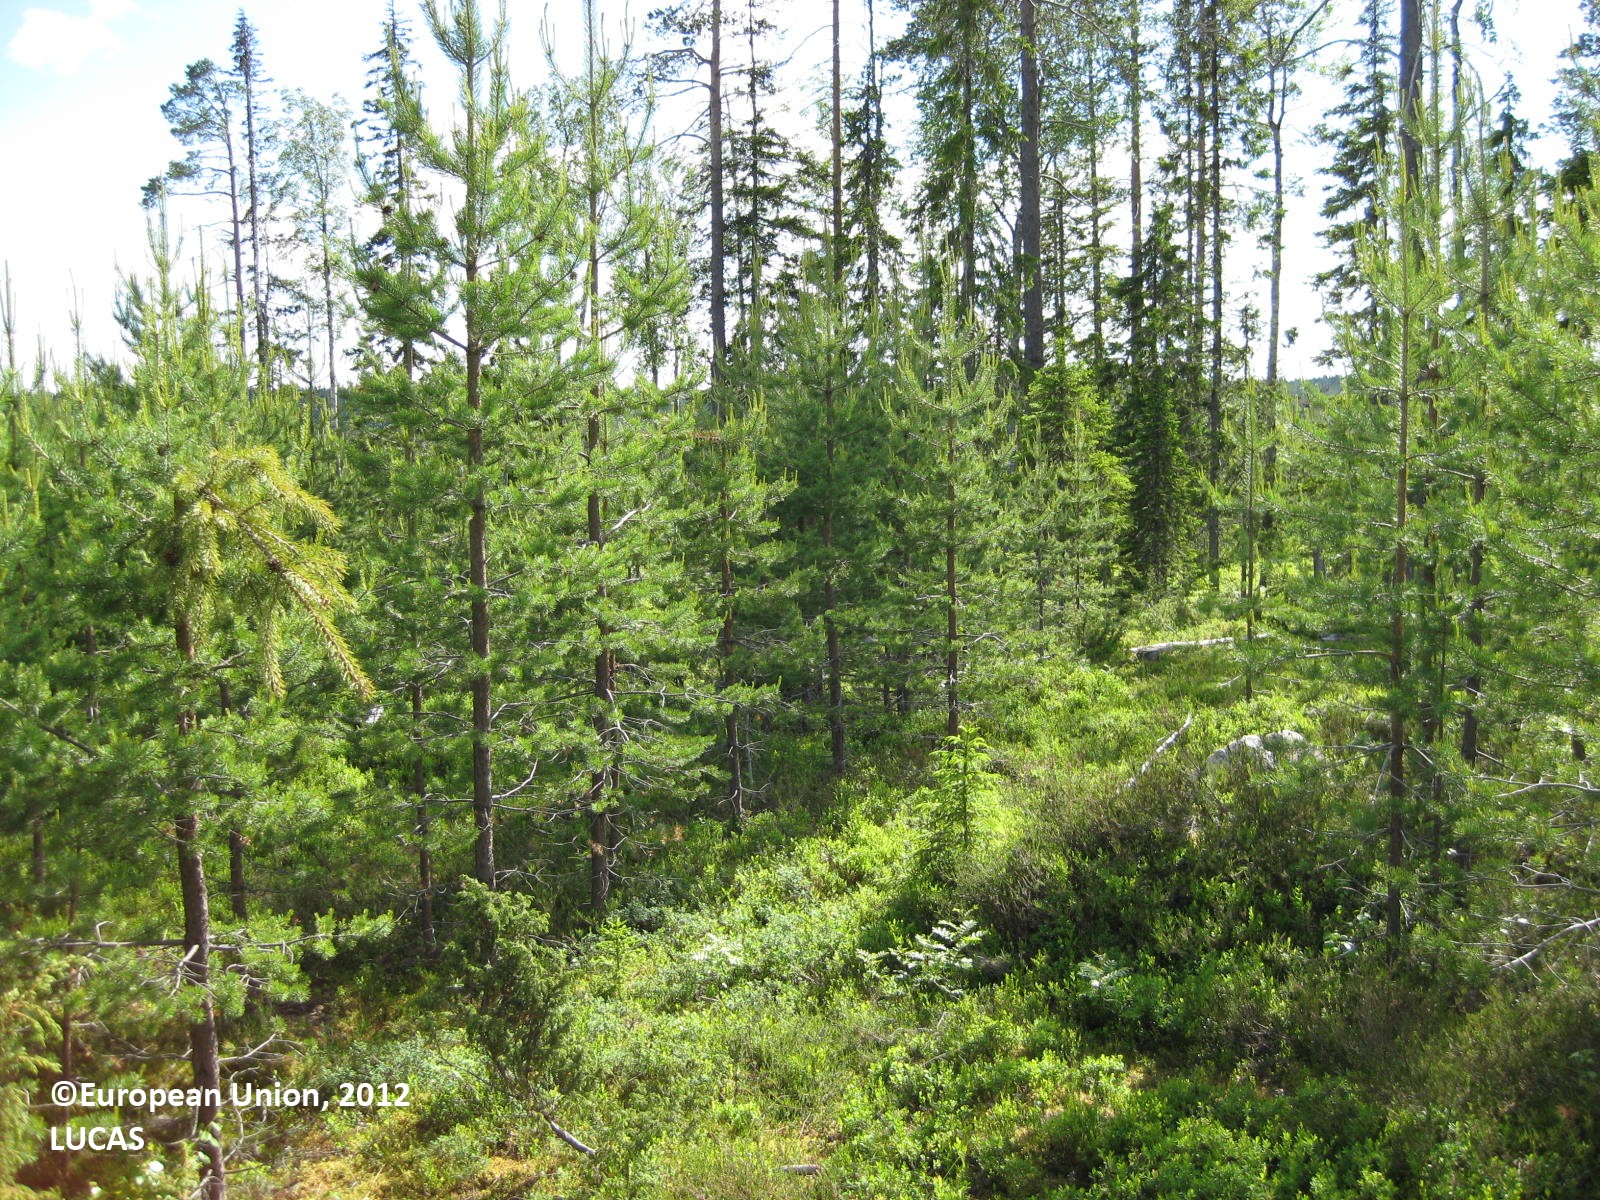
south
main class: Woodland
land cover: Pine dominated coniferous woodland
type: boreal forest
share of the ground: > 75 %
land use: Forestry
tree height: > 5 m
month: July
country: FI
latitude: 65.5962
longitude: 29.4343
